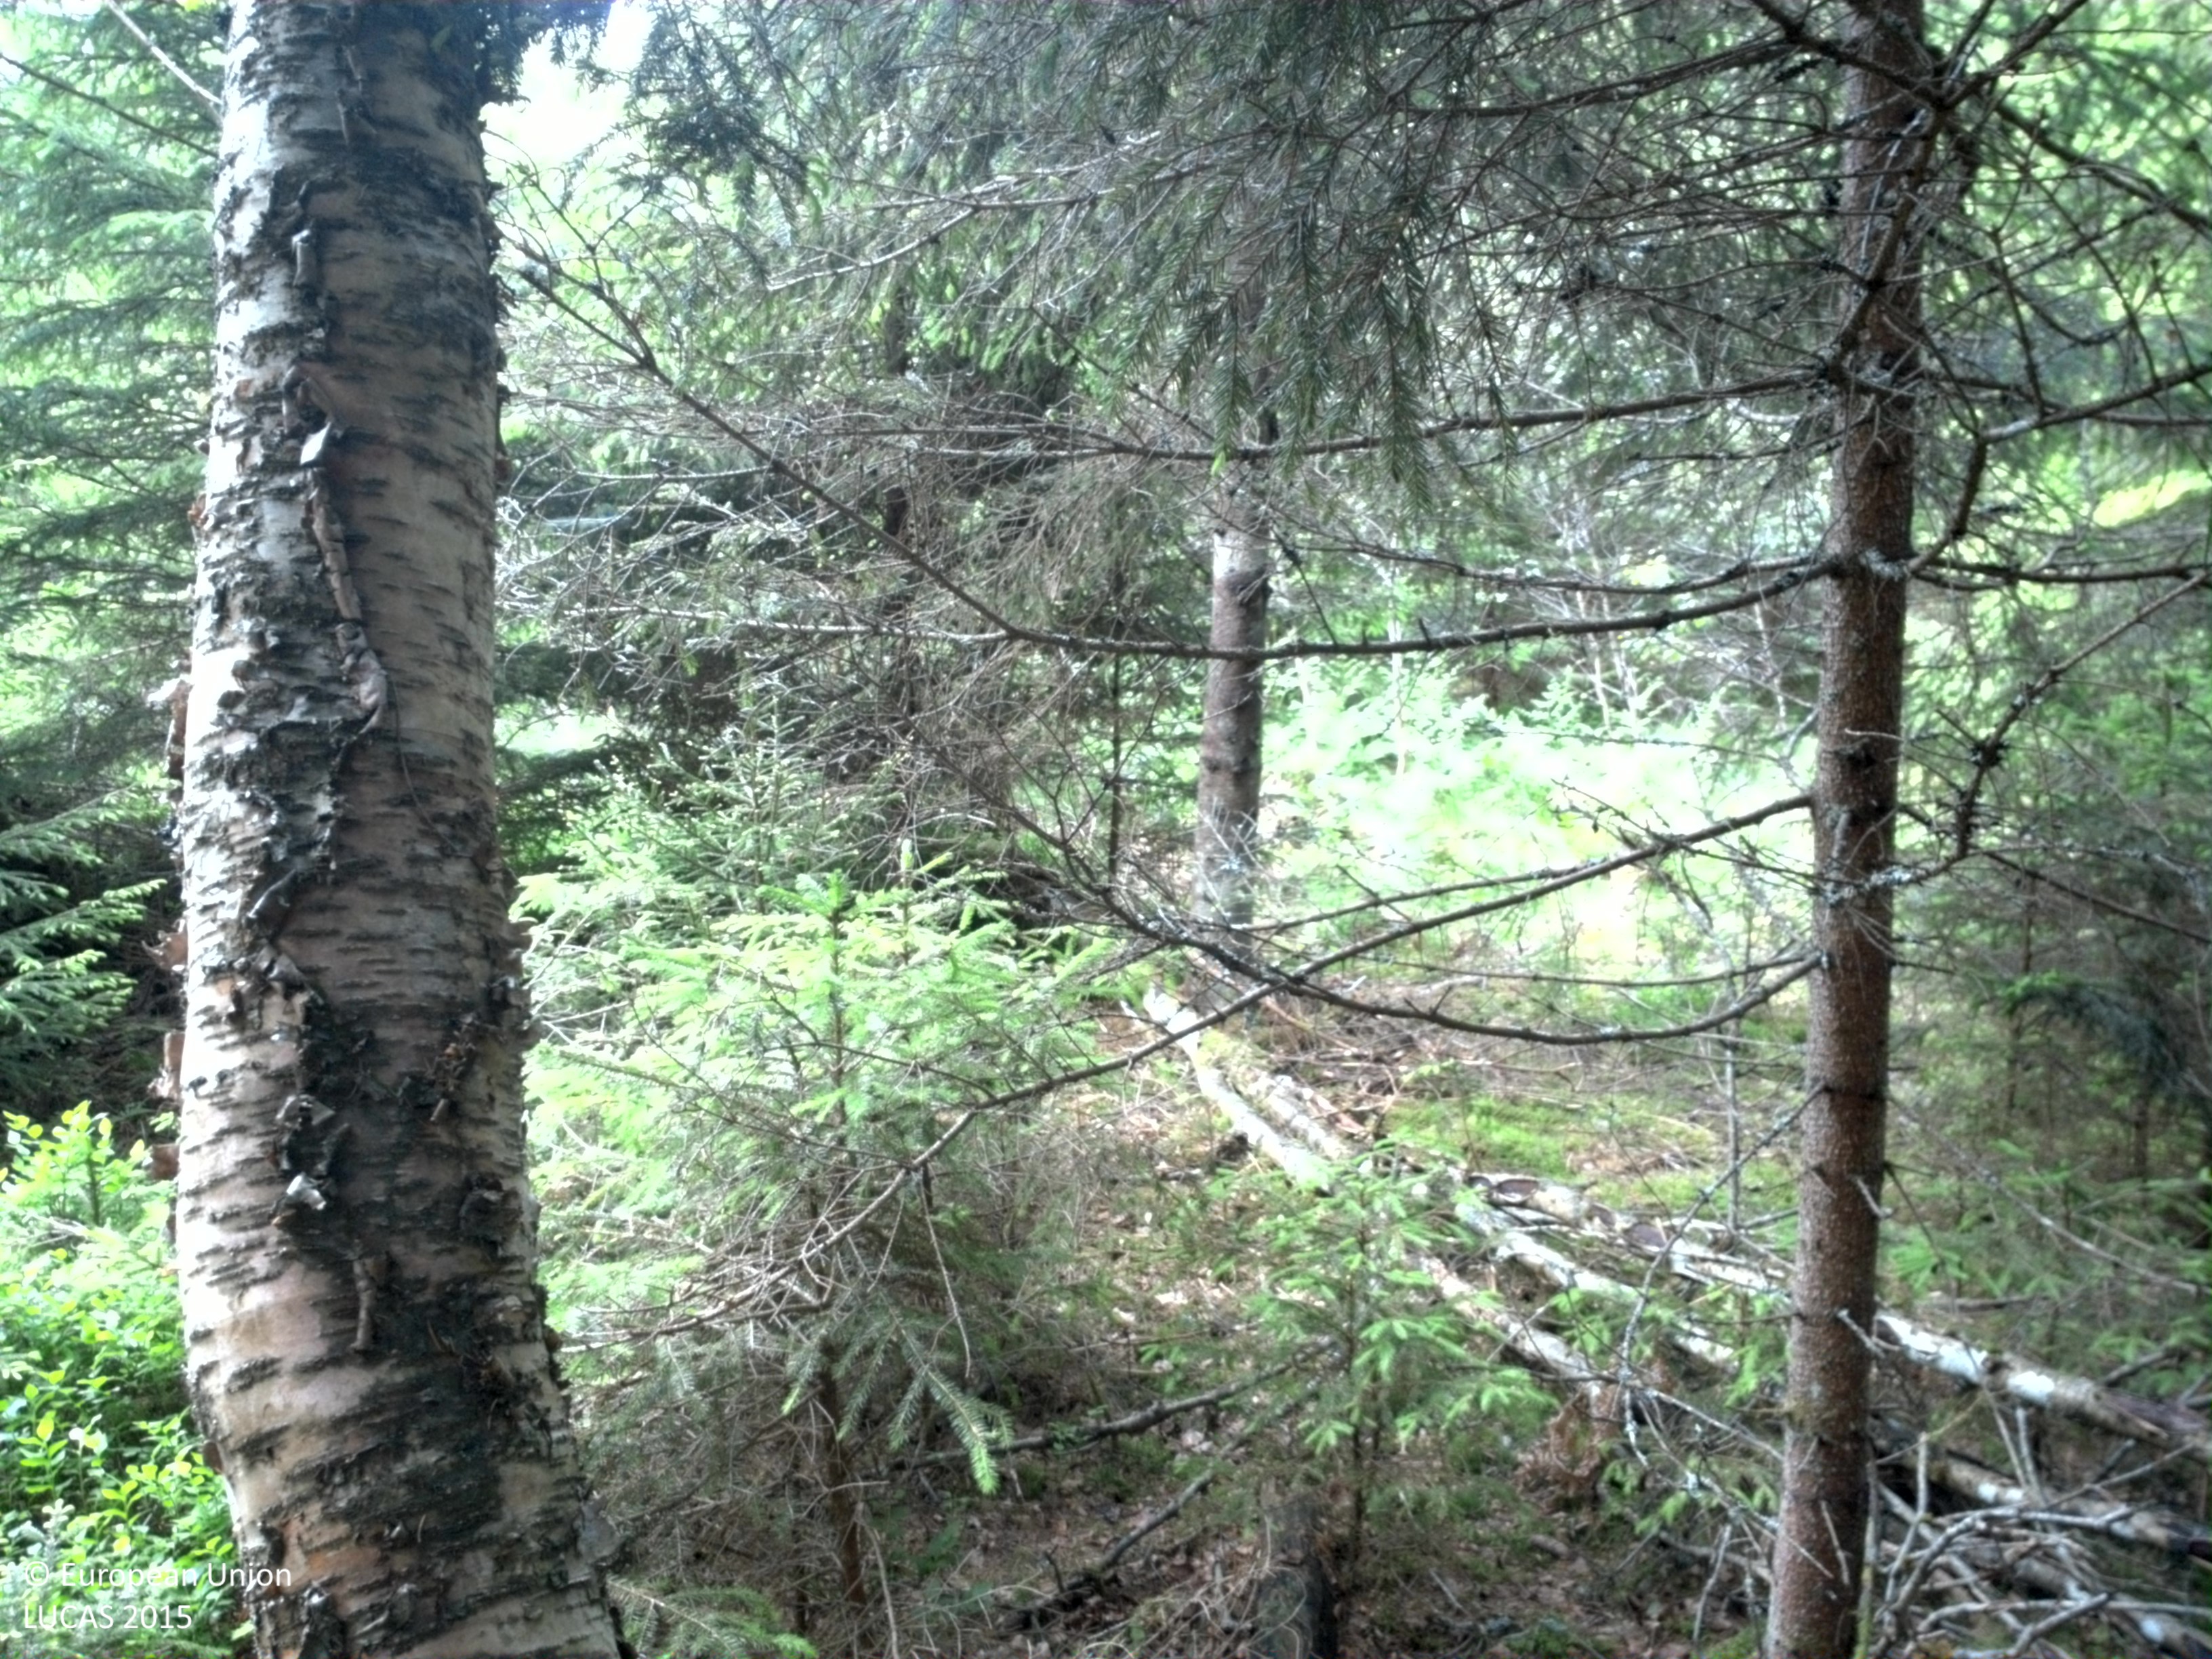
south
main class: Woodland
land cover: Spruce dominated coniferous woodland
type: boreal forest
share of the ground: 25 - 50 %
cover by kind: coniferous forest trees 50 %, lichens and mosses 20 %, consolidated bare surface 20 %, herbaceous plants 10 %
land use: Forestry
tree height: > 5 m
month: June
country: SE
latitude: 58.5754
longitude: 15.5139
